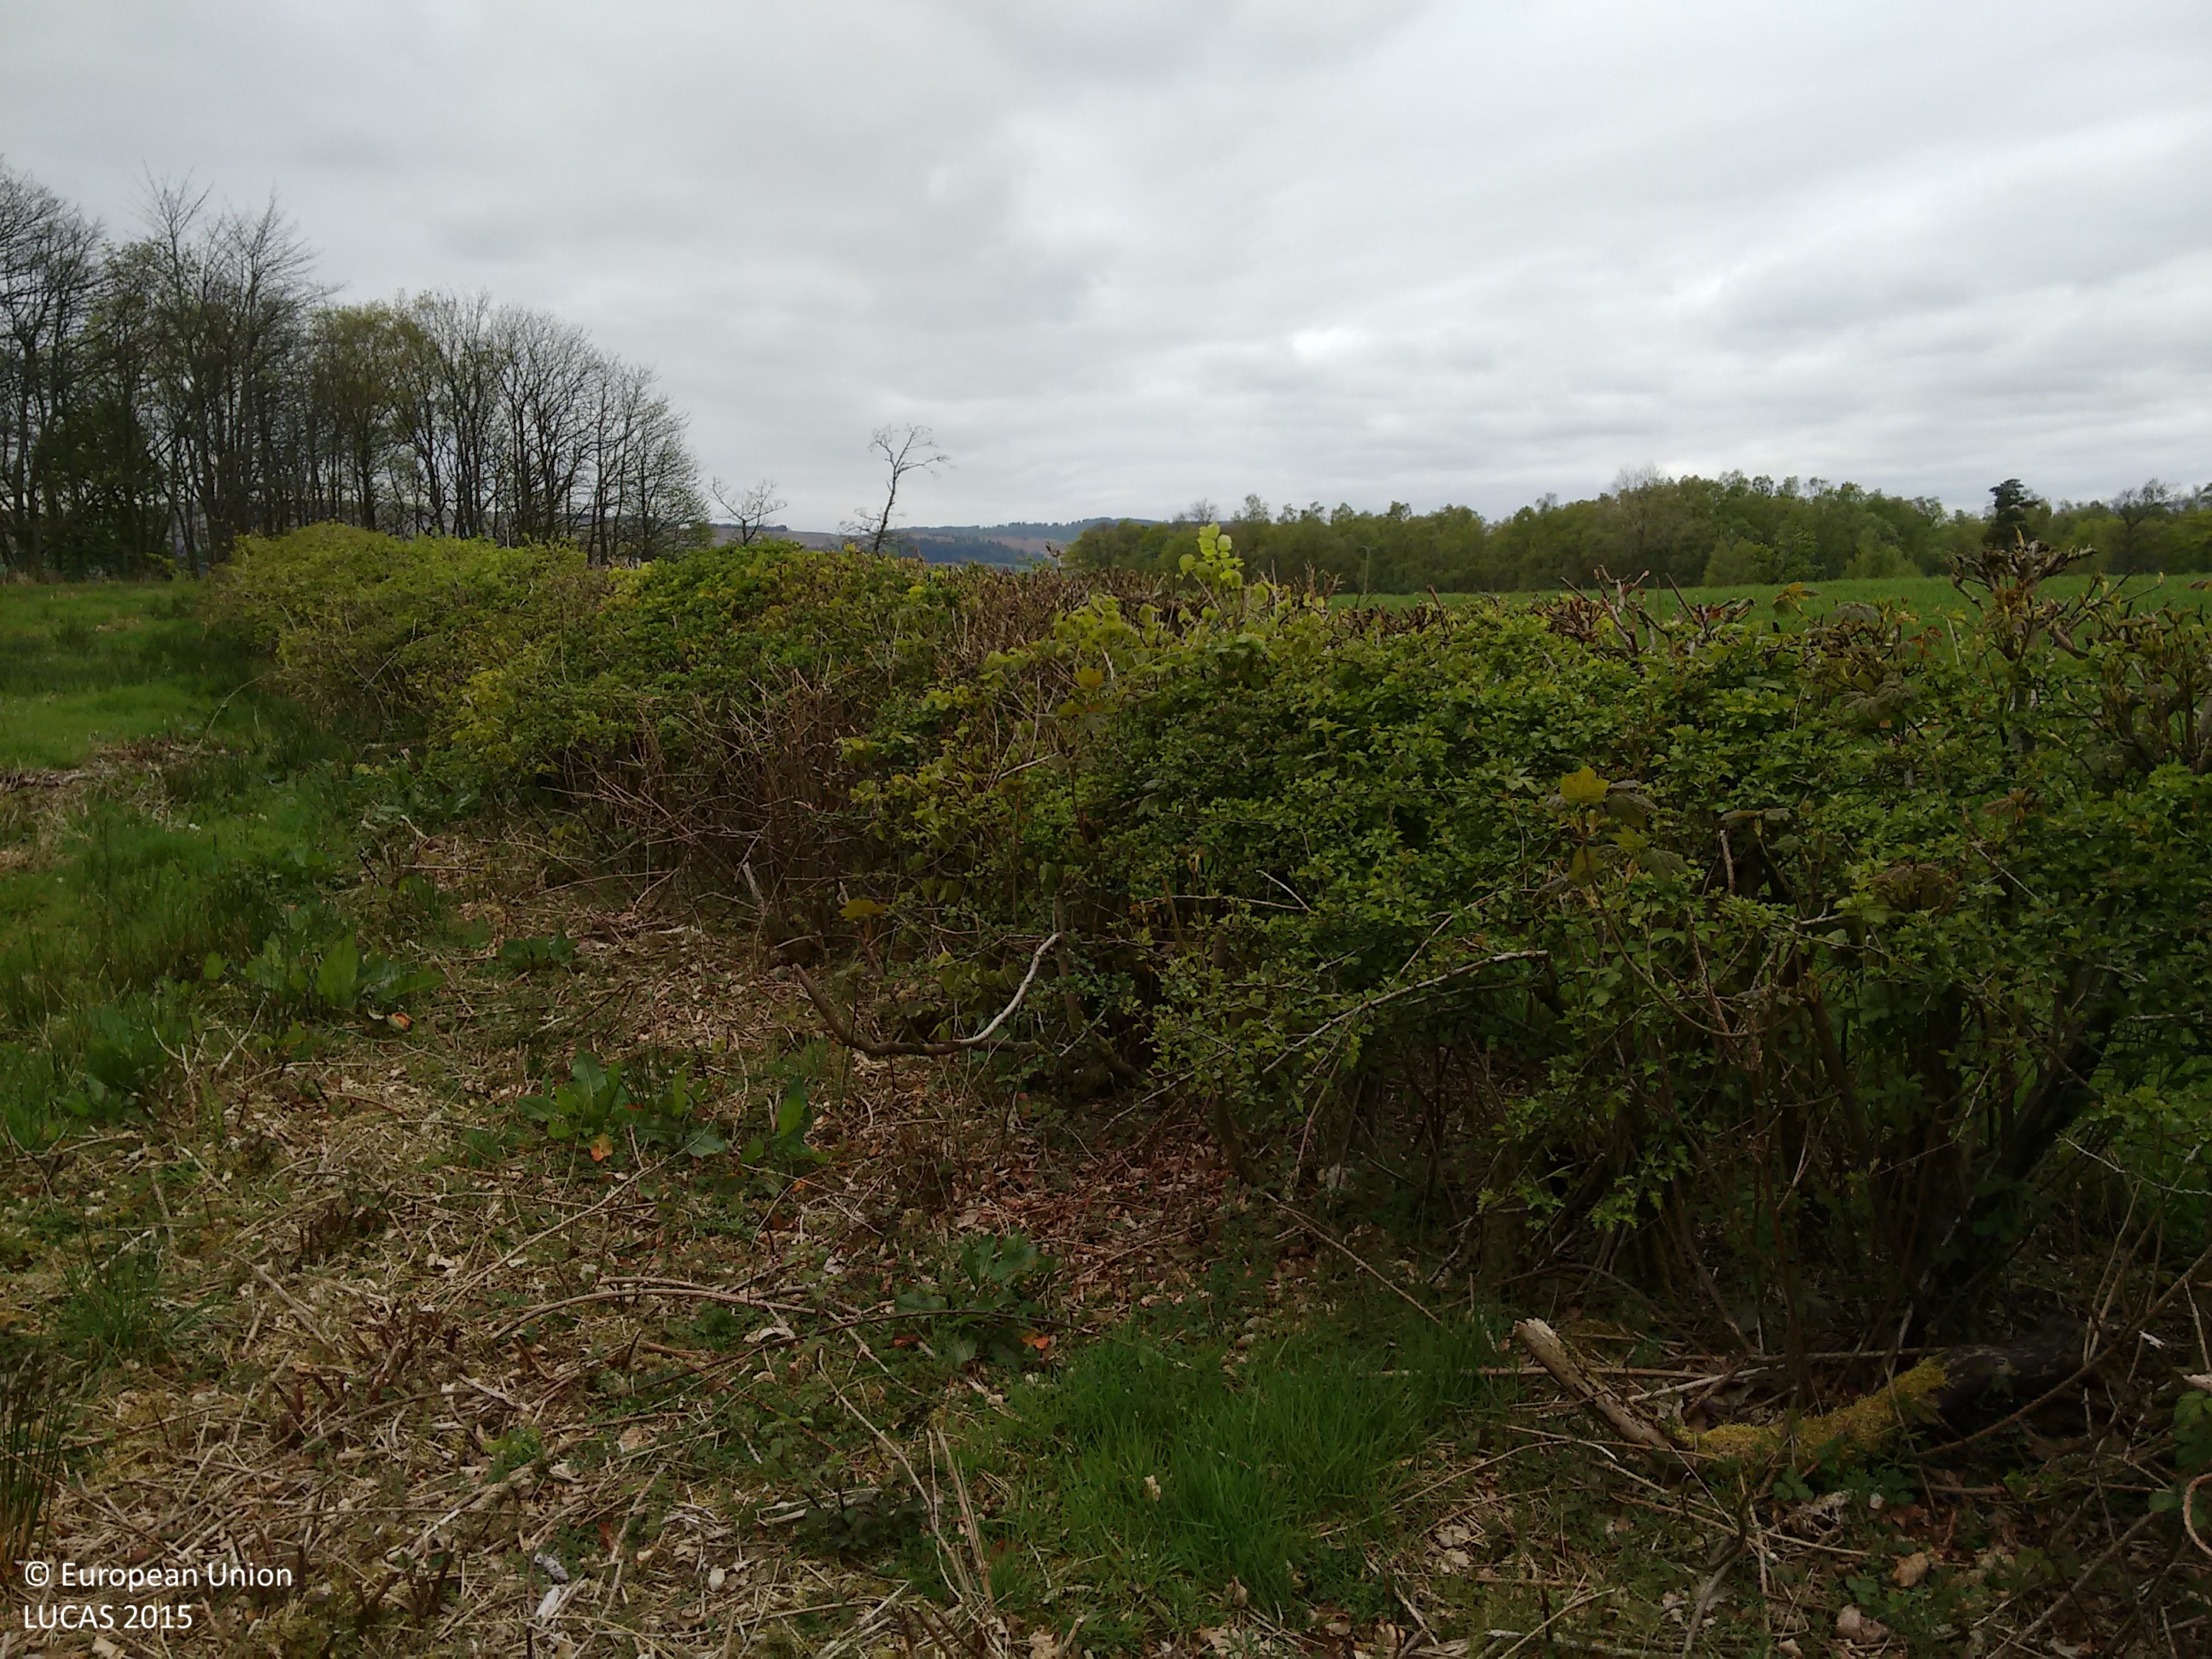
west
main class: Grassland
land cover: Grassland without tree/shrub cover
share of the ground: > 75 %
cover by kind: herbaceous plants 90 %, shrubs 5 %, unconsolidated bare surface 5 %
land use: Semi-natural and natural areas not in use
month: May
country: GB
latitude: 56.0111
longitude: -4.5507
